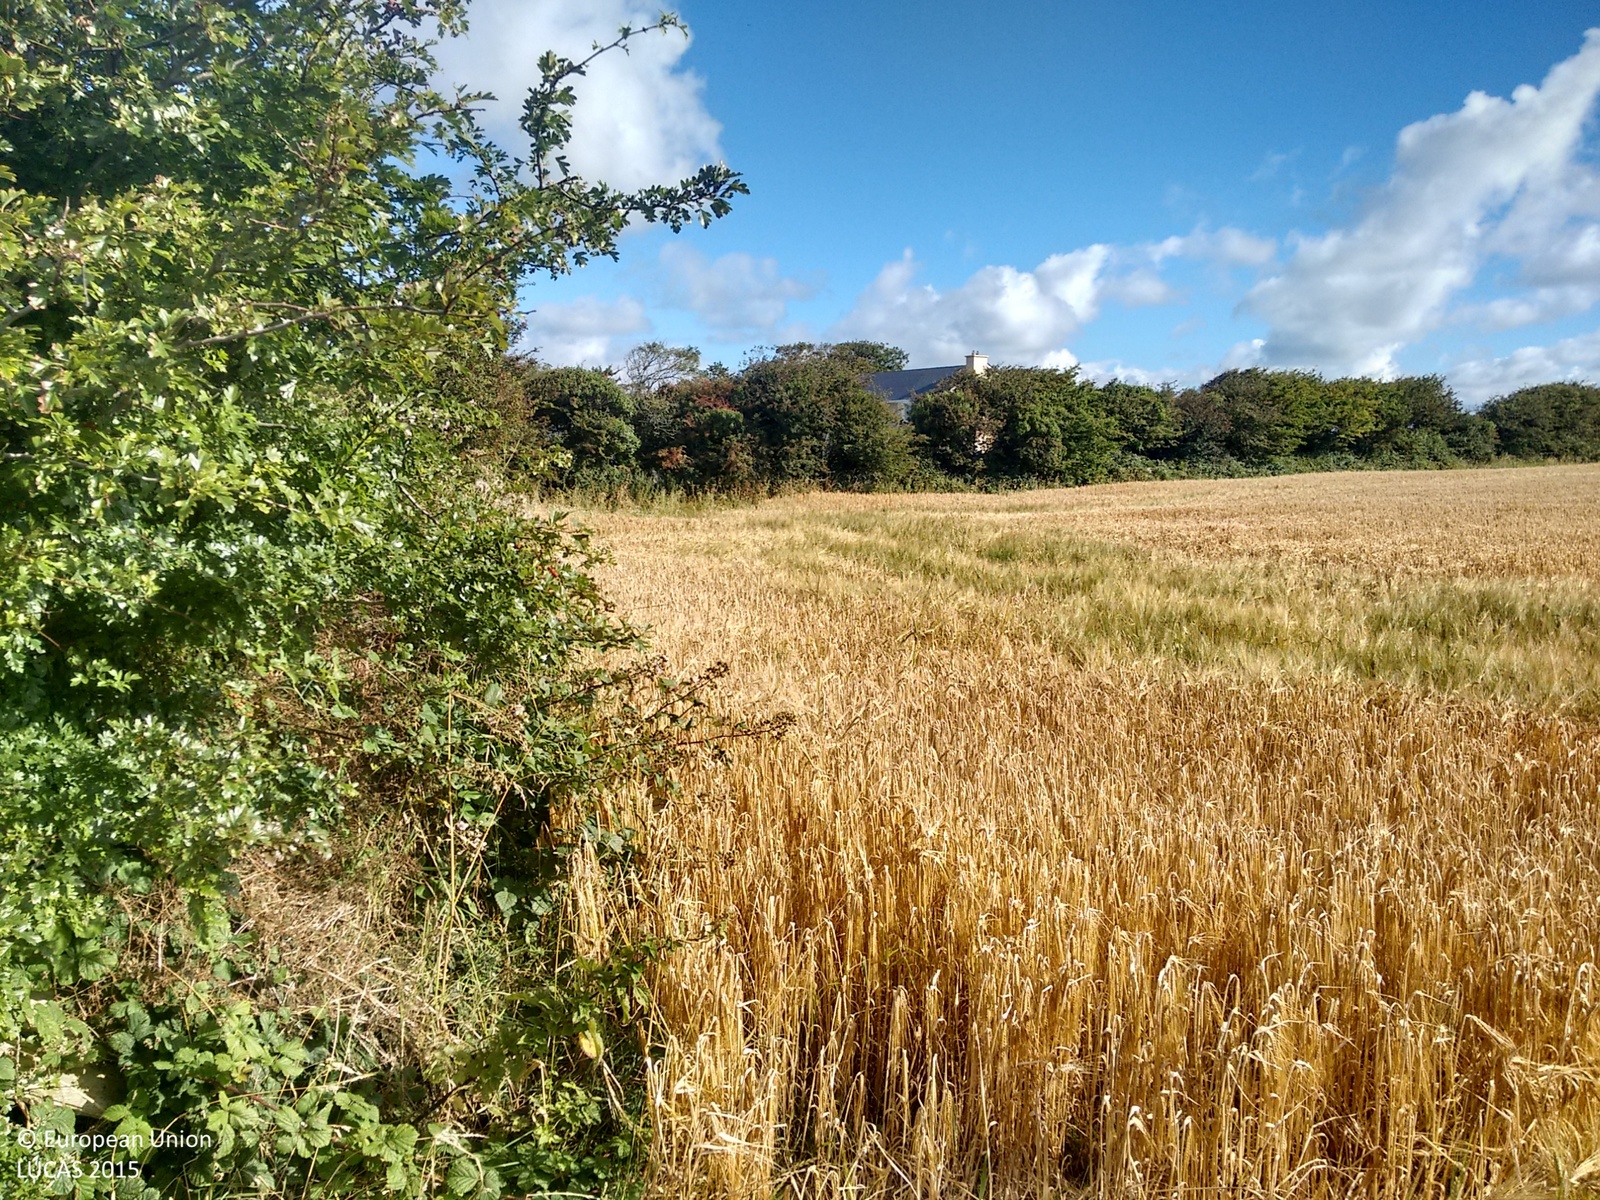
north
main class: Cropland
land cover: Barley
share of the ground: > 75 %
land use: Agriculture (excluding fallow land and kitchen gardens)
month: September
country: IE
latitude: 52.3165
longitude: -9.8003
